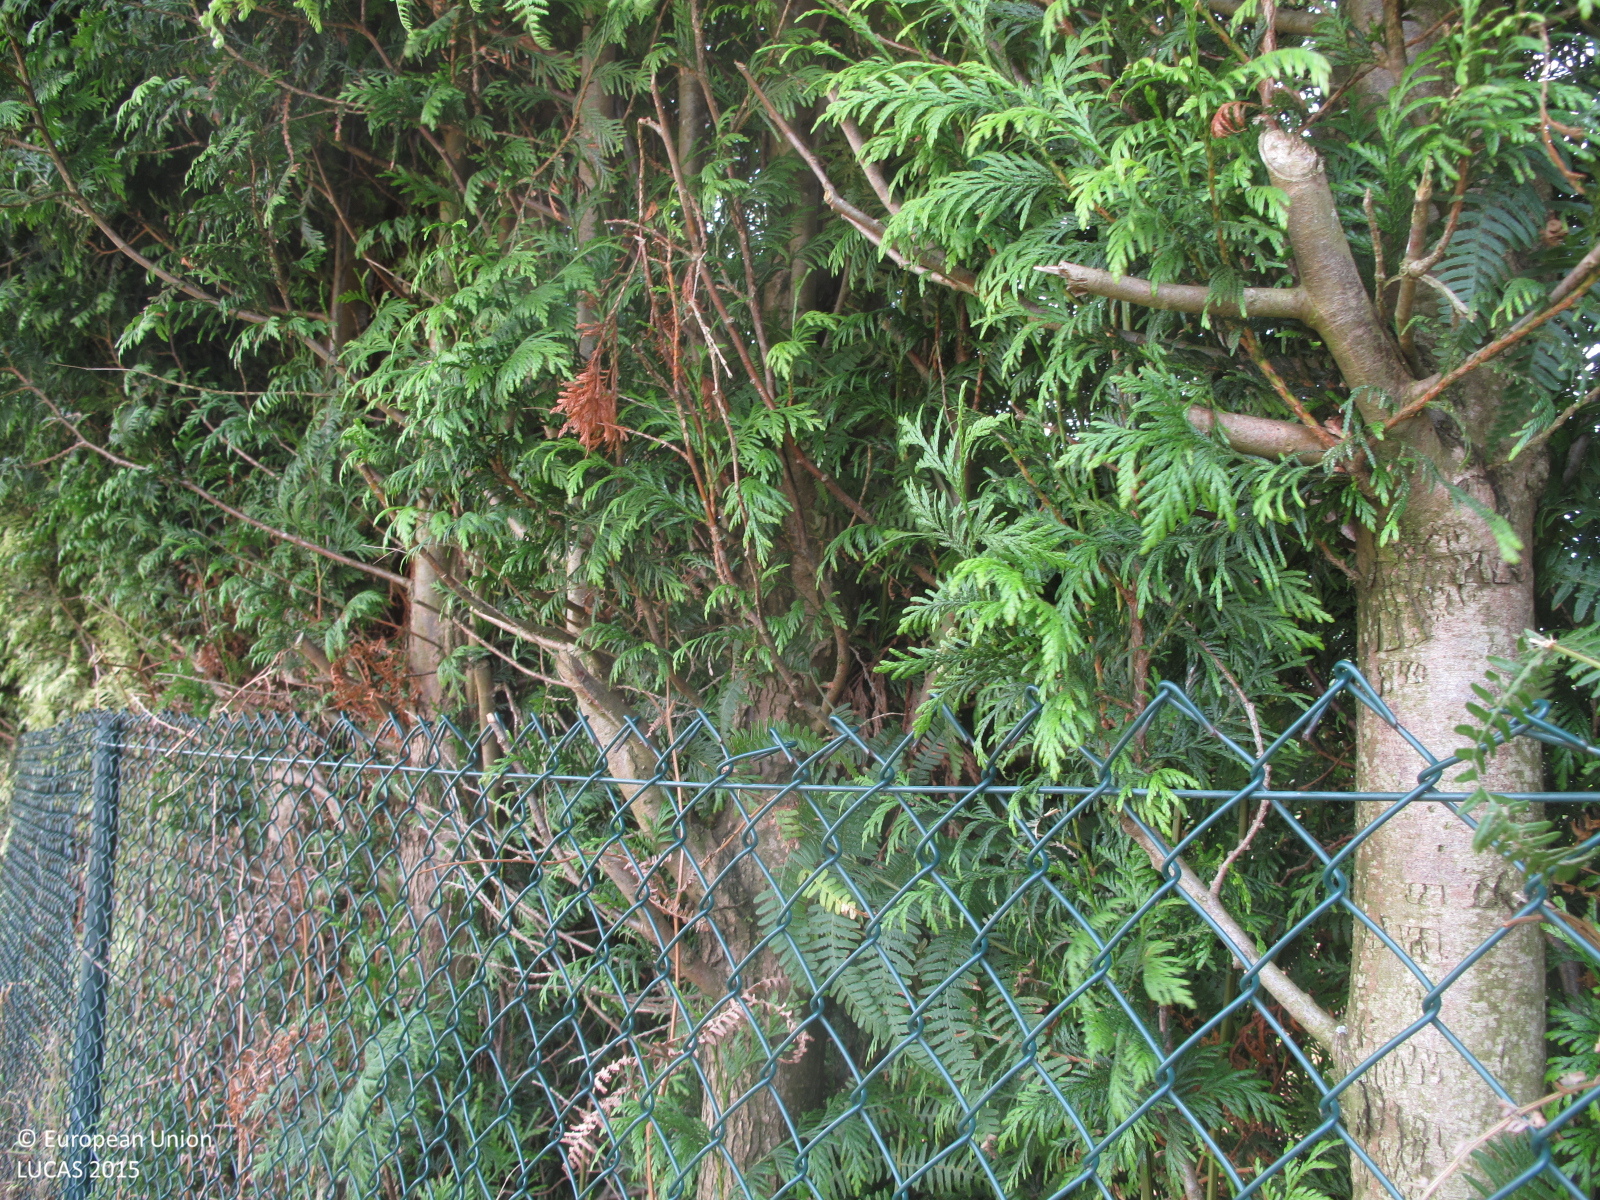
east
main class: Grassland
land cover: Grassland with sparse tree/shrub cover
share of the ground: > 75 %
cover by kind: herbaceous plants 90 %, broadleaved forest trees 5 %, unconsolidated bare surface 5 %
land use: Forestry
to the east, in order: Grassland with sparse tree/shrub cover; Managed hedges; Artificial constructions in urban areas; Abandoned hedges; Grassland with sparse tree/shrub cover; Broadleaved woodland; Grassland without tree/shrub cover; Broadleaved woodland; Grassland without tree/shrub cover
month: July
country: ES
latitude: 43.4522
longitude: -8.1548
